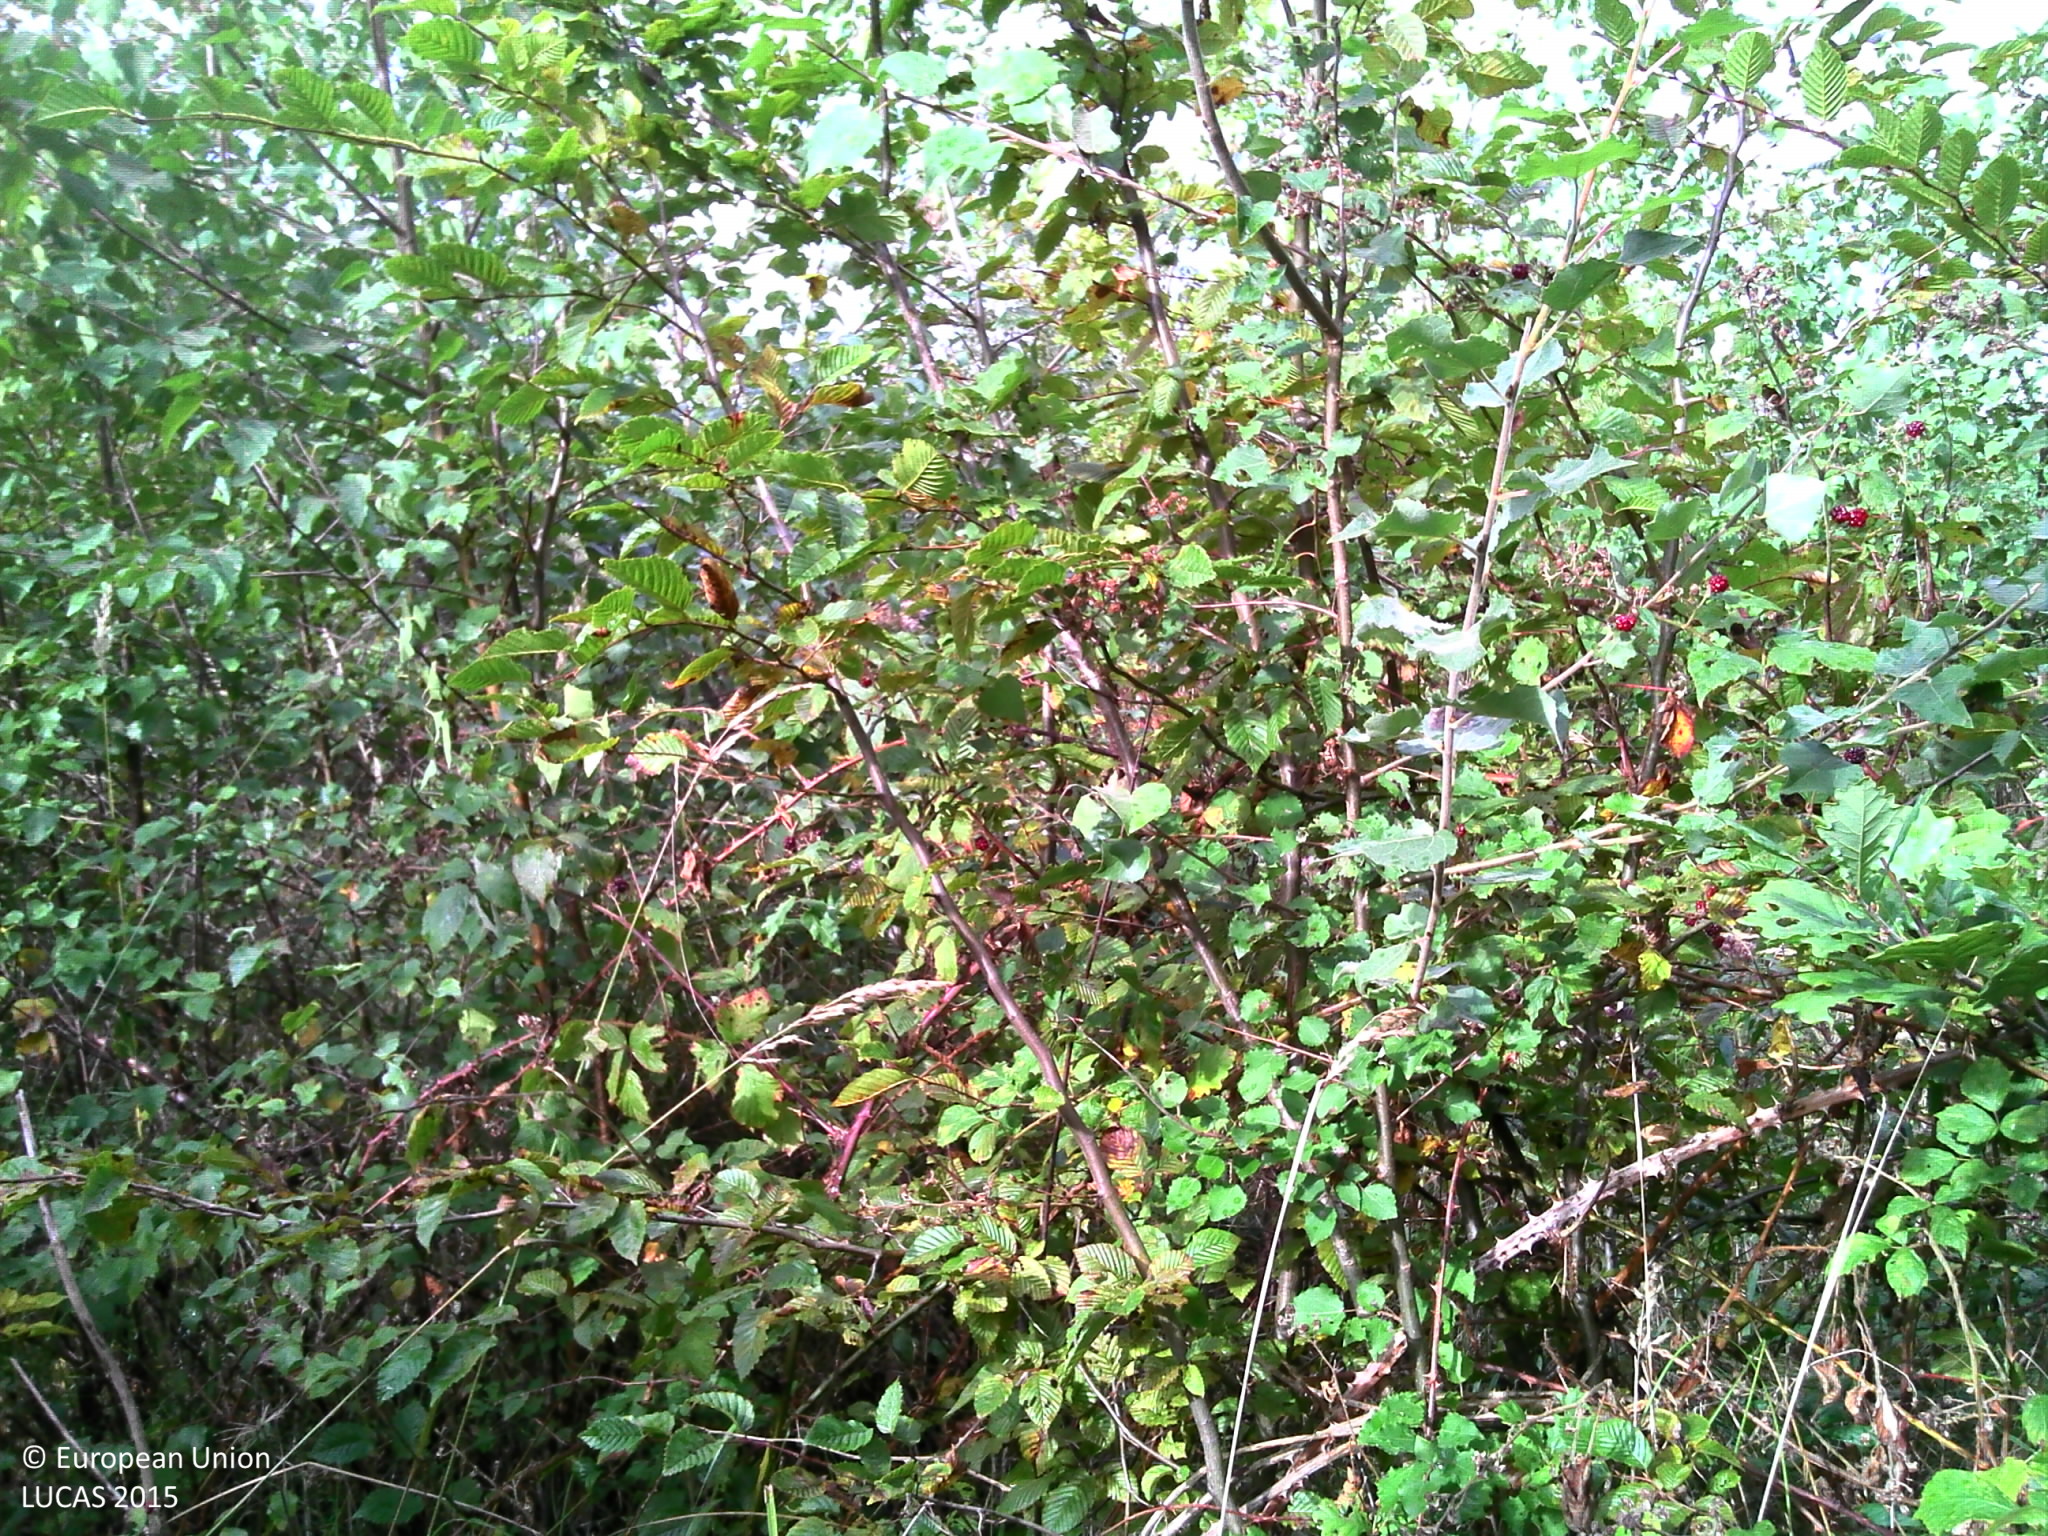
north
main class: Woodland
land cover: Broadleaved woodland
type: mesophytic deciduous forest
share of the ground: > 75 %
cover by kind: broadleaved forest trees 80 %, shrubs 10 %, herbaceous plants 10 %
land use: Forestry
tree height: > 5 m
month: September
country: FR
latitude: 47.1030
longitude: 5.0598
